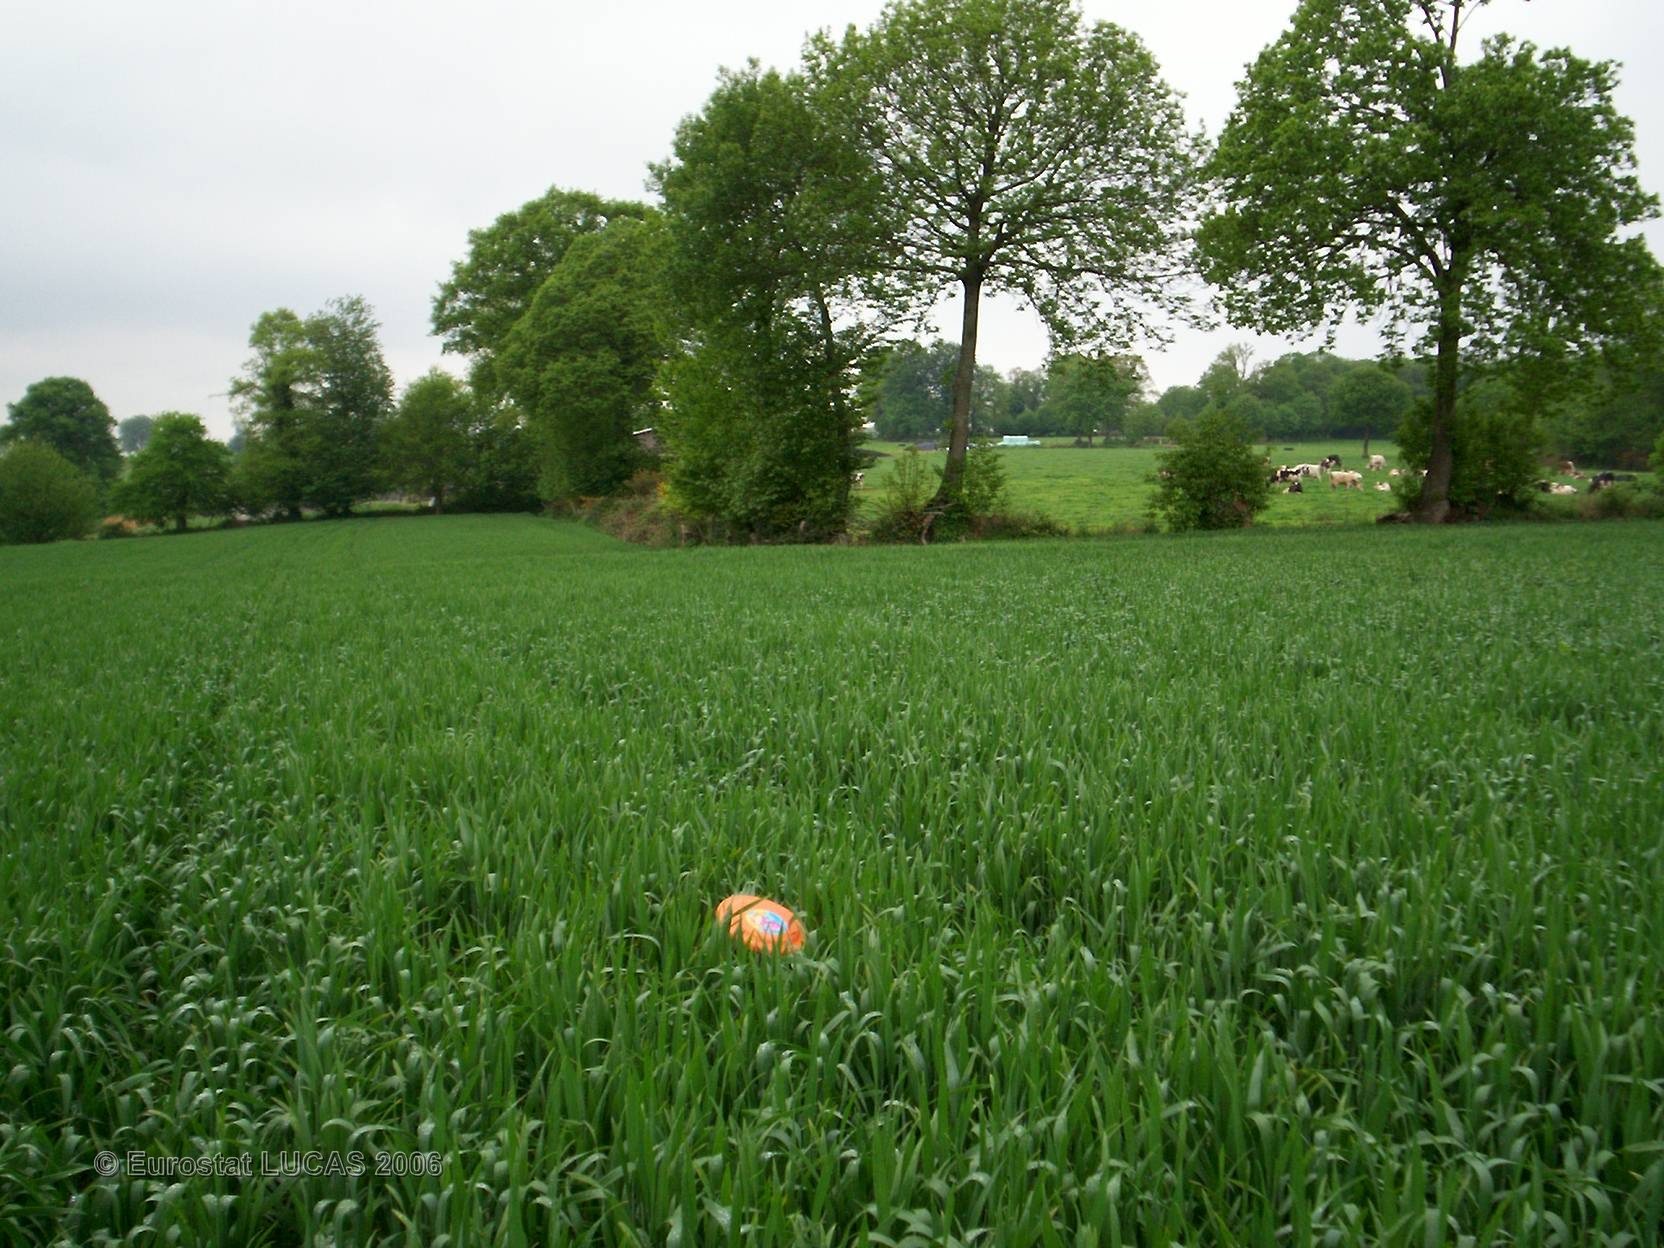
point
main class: Cropland
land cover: Common wheat
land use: Agriculture (excluding fallow land and kitchen gardens)
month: May
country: FR
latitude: 48.4121
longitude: -1.2161
